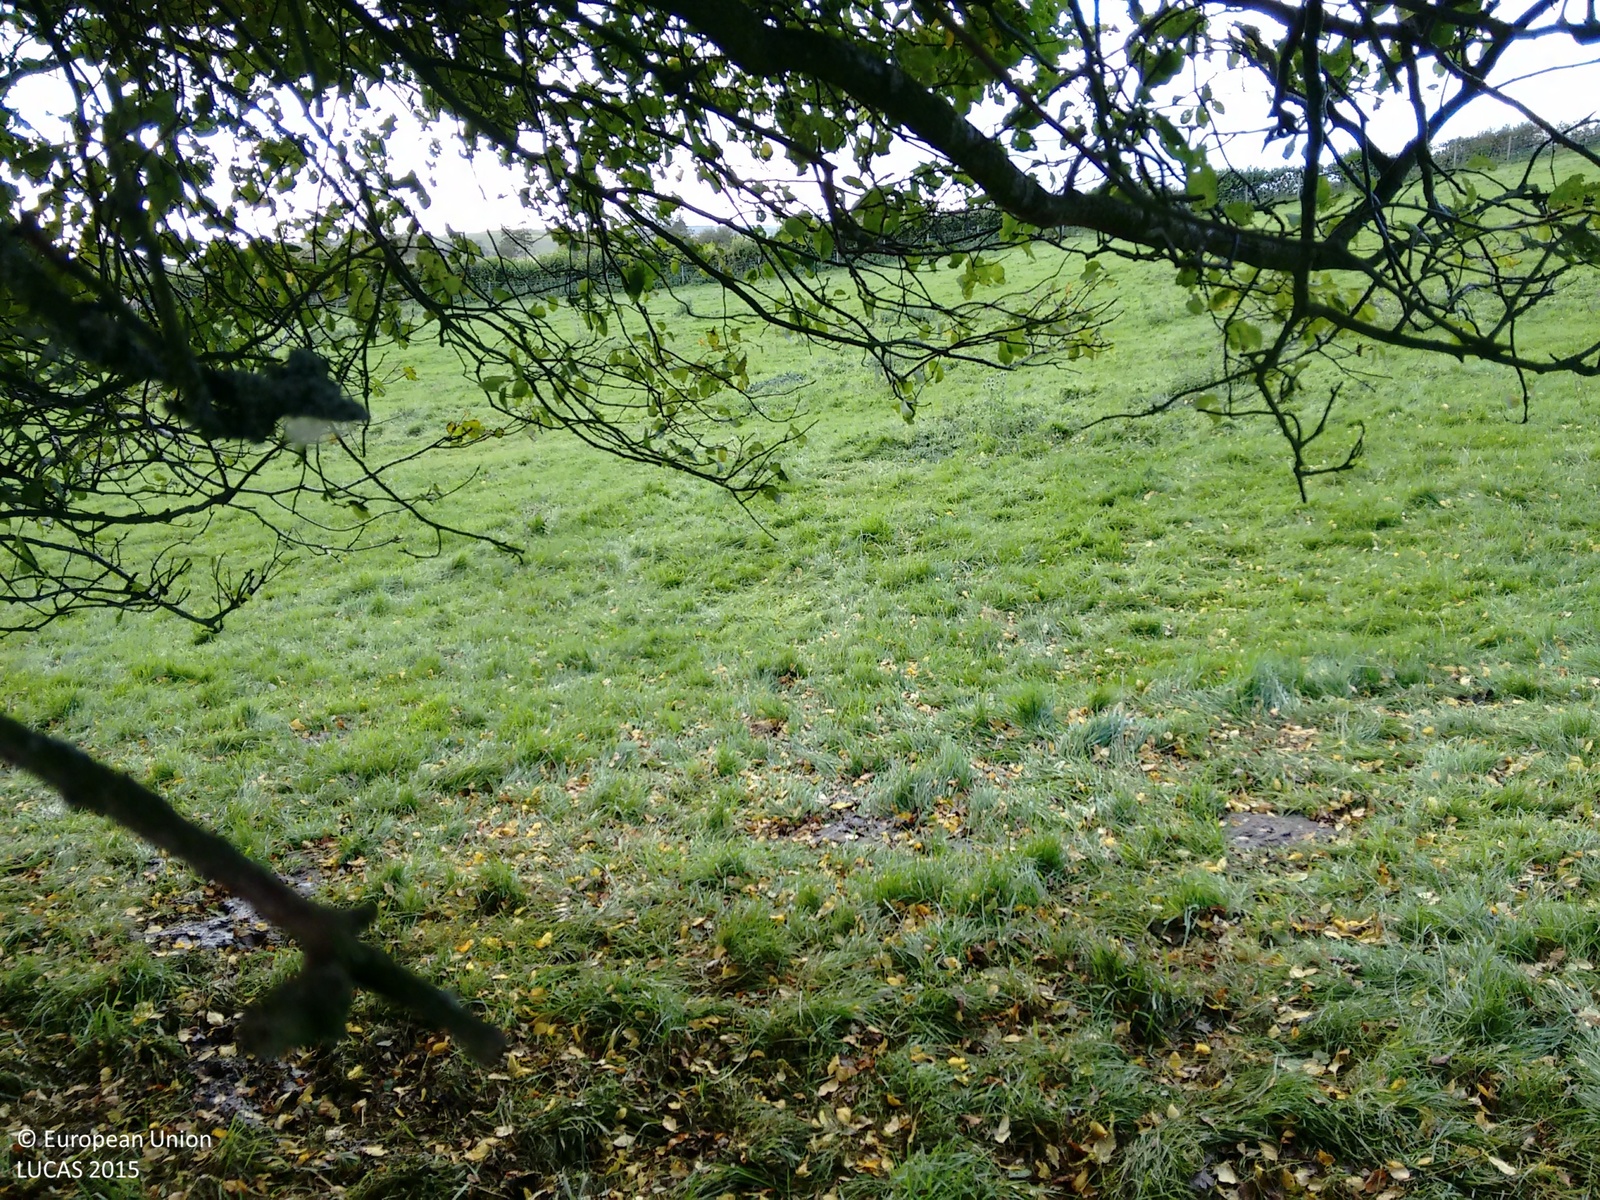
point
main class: Grassland
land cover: Grassland without tree/shrub cover
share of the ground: > 75 %
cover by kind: herbaceous plants 100 %
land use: Agriculture (excluding fallow land and kitchen gardens)
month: October
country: GB
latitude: 52.3706
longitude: -3.3144
